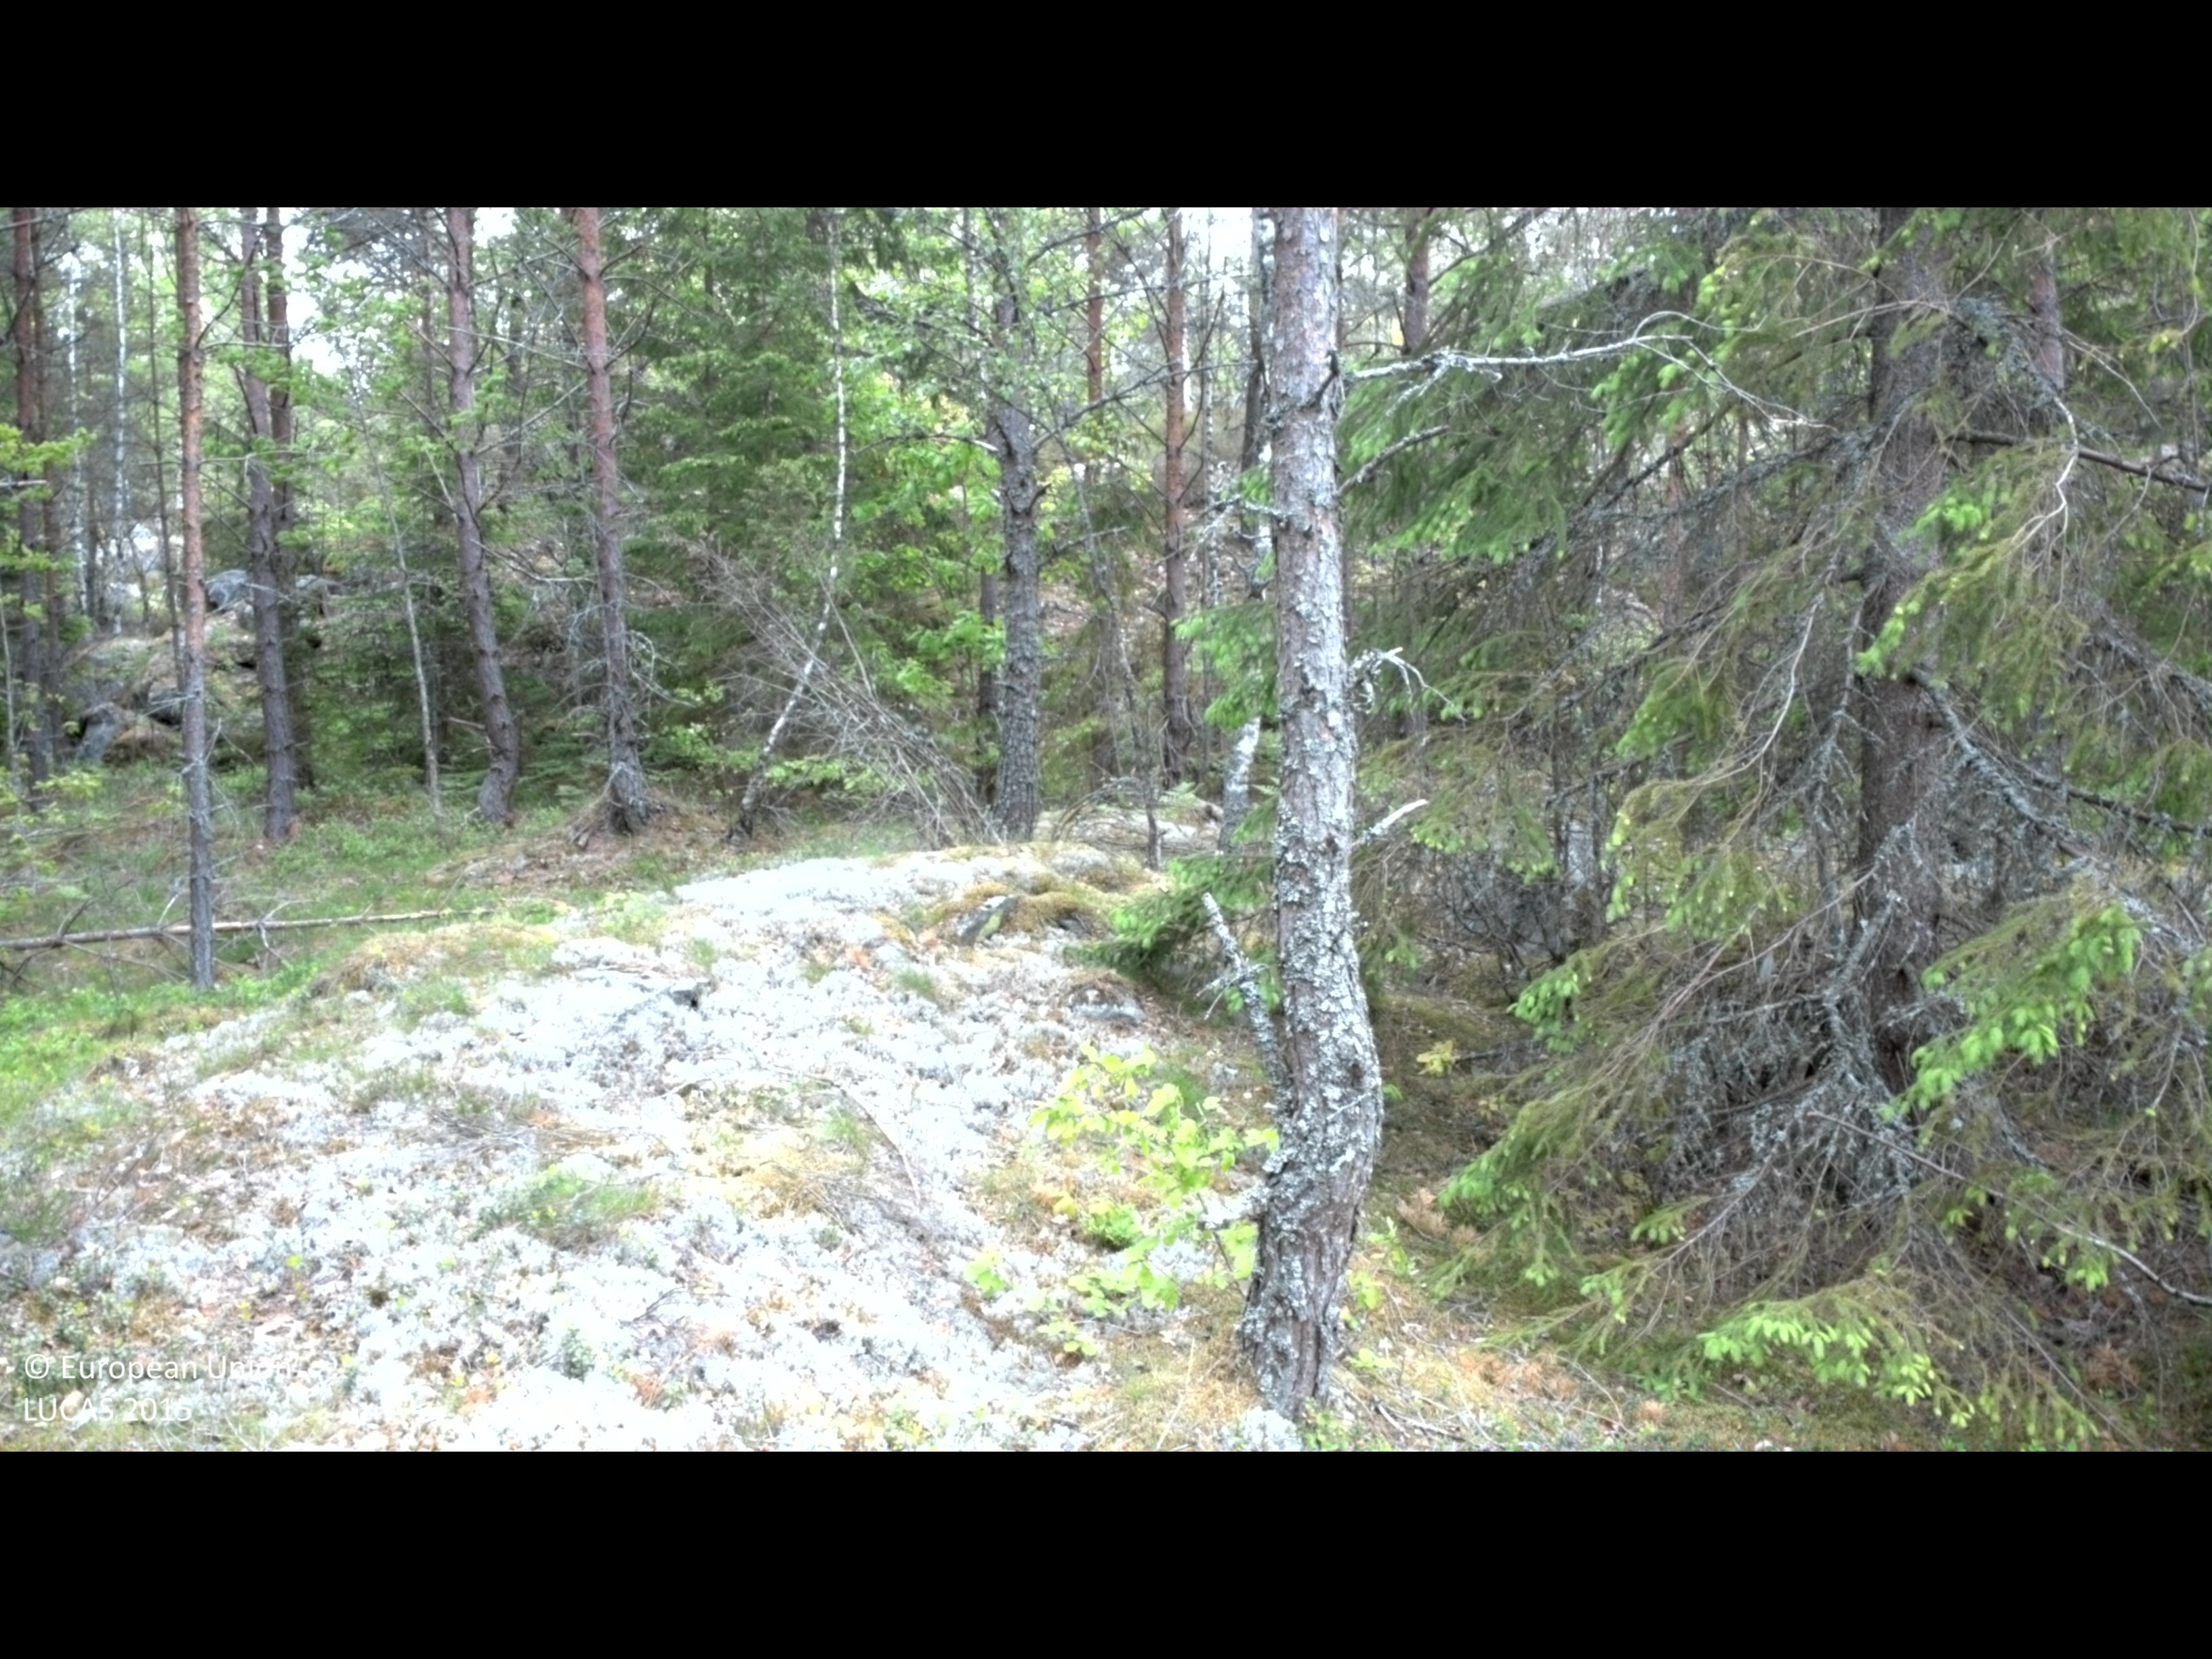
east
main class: Woodland
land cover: Pine dominated coniferous woodland
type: boreal forest
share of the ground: 50 - 75 %
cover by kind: coniferous forest trees 50 %, shrubs 25 %, lichens and mosses 15 %, broadleaved forest trees 10 %
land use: Forestry
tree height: > 5 m
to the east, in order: Pine dominated coniferous woodland; Pine dominated mixed woodland; Lichens and moss; Pine dominated mixed woodland; Spruce dominated mixed woodland; Pine dominated mixed woodland
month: June
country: SE
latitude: 57.6607
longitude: 16.2162
